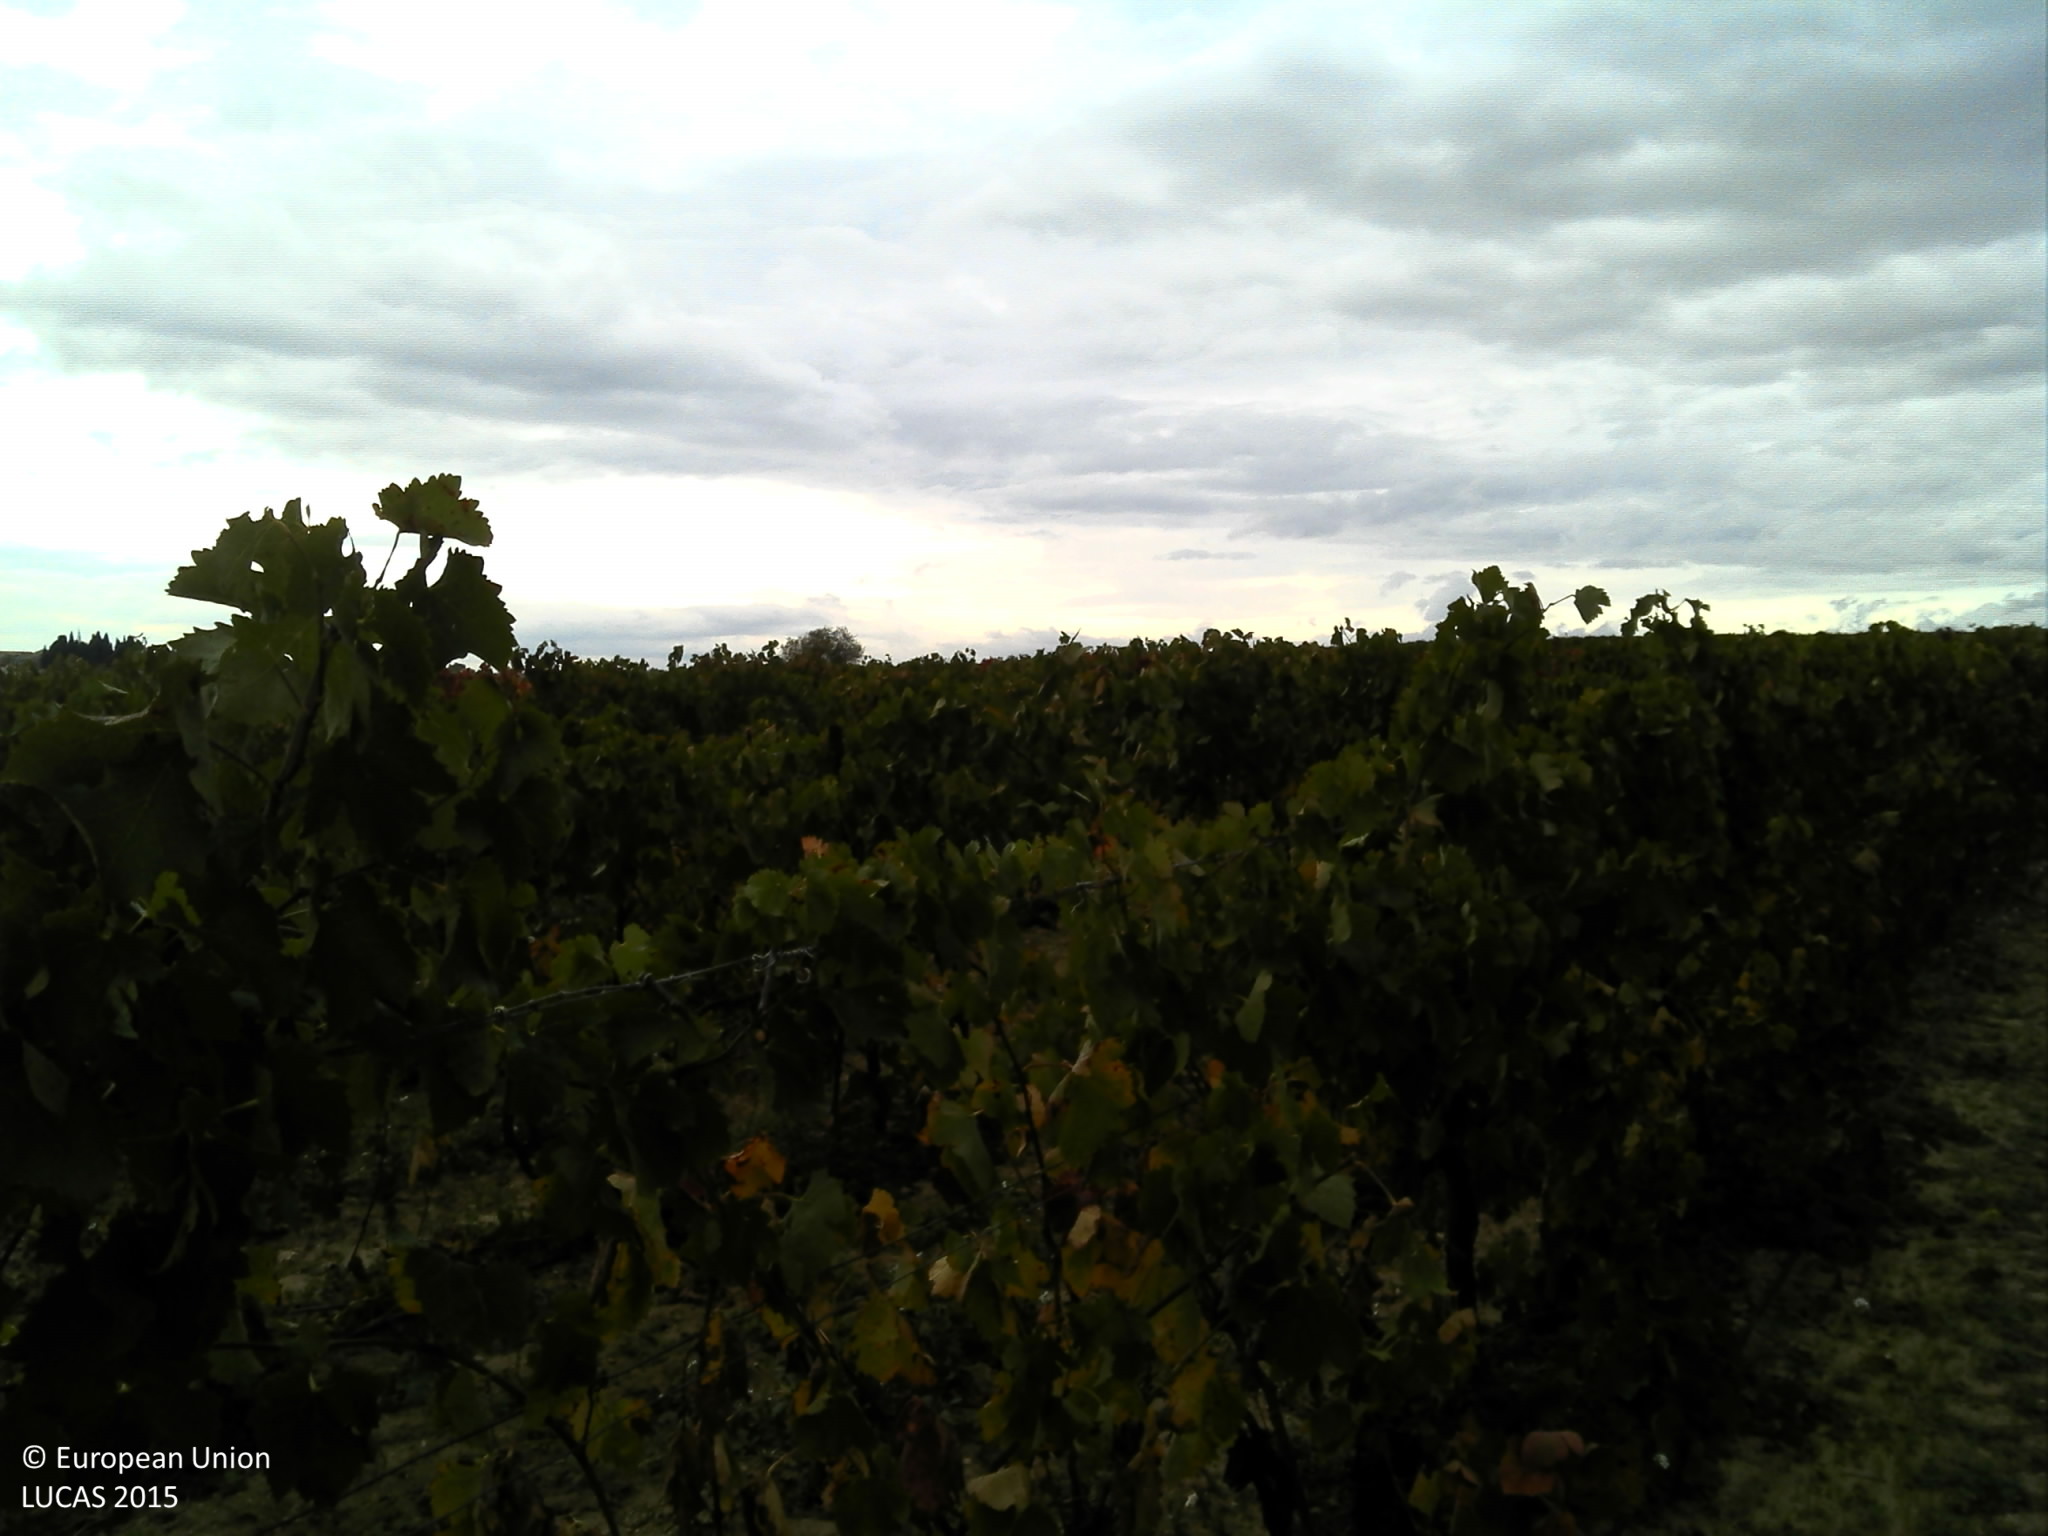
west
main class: Cropland
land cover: Vineyards
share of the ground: 10 - 25 %
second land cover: Spontaneously vegetated surfaces
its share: 50 - 75 %
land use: Agriculture (excluding fallow land and kitchen gardens)
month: October
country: FR
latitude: 43.3629
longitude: 3.1360
